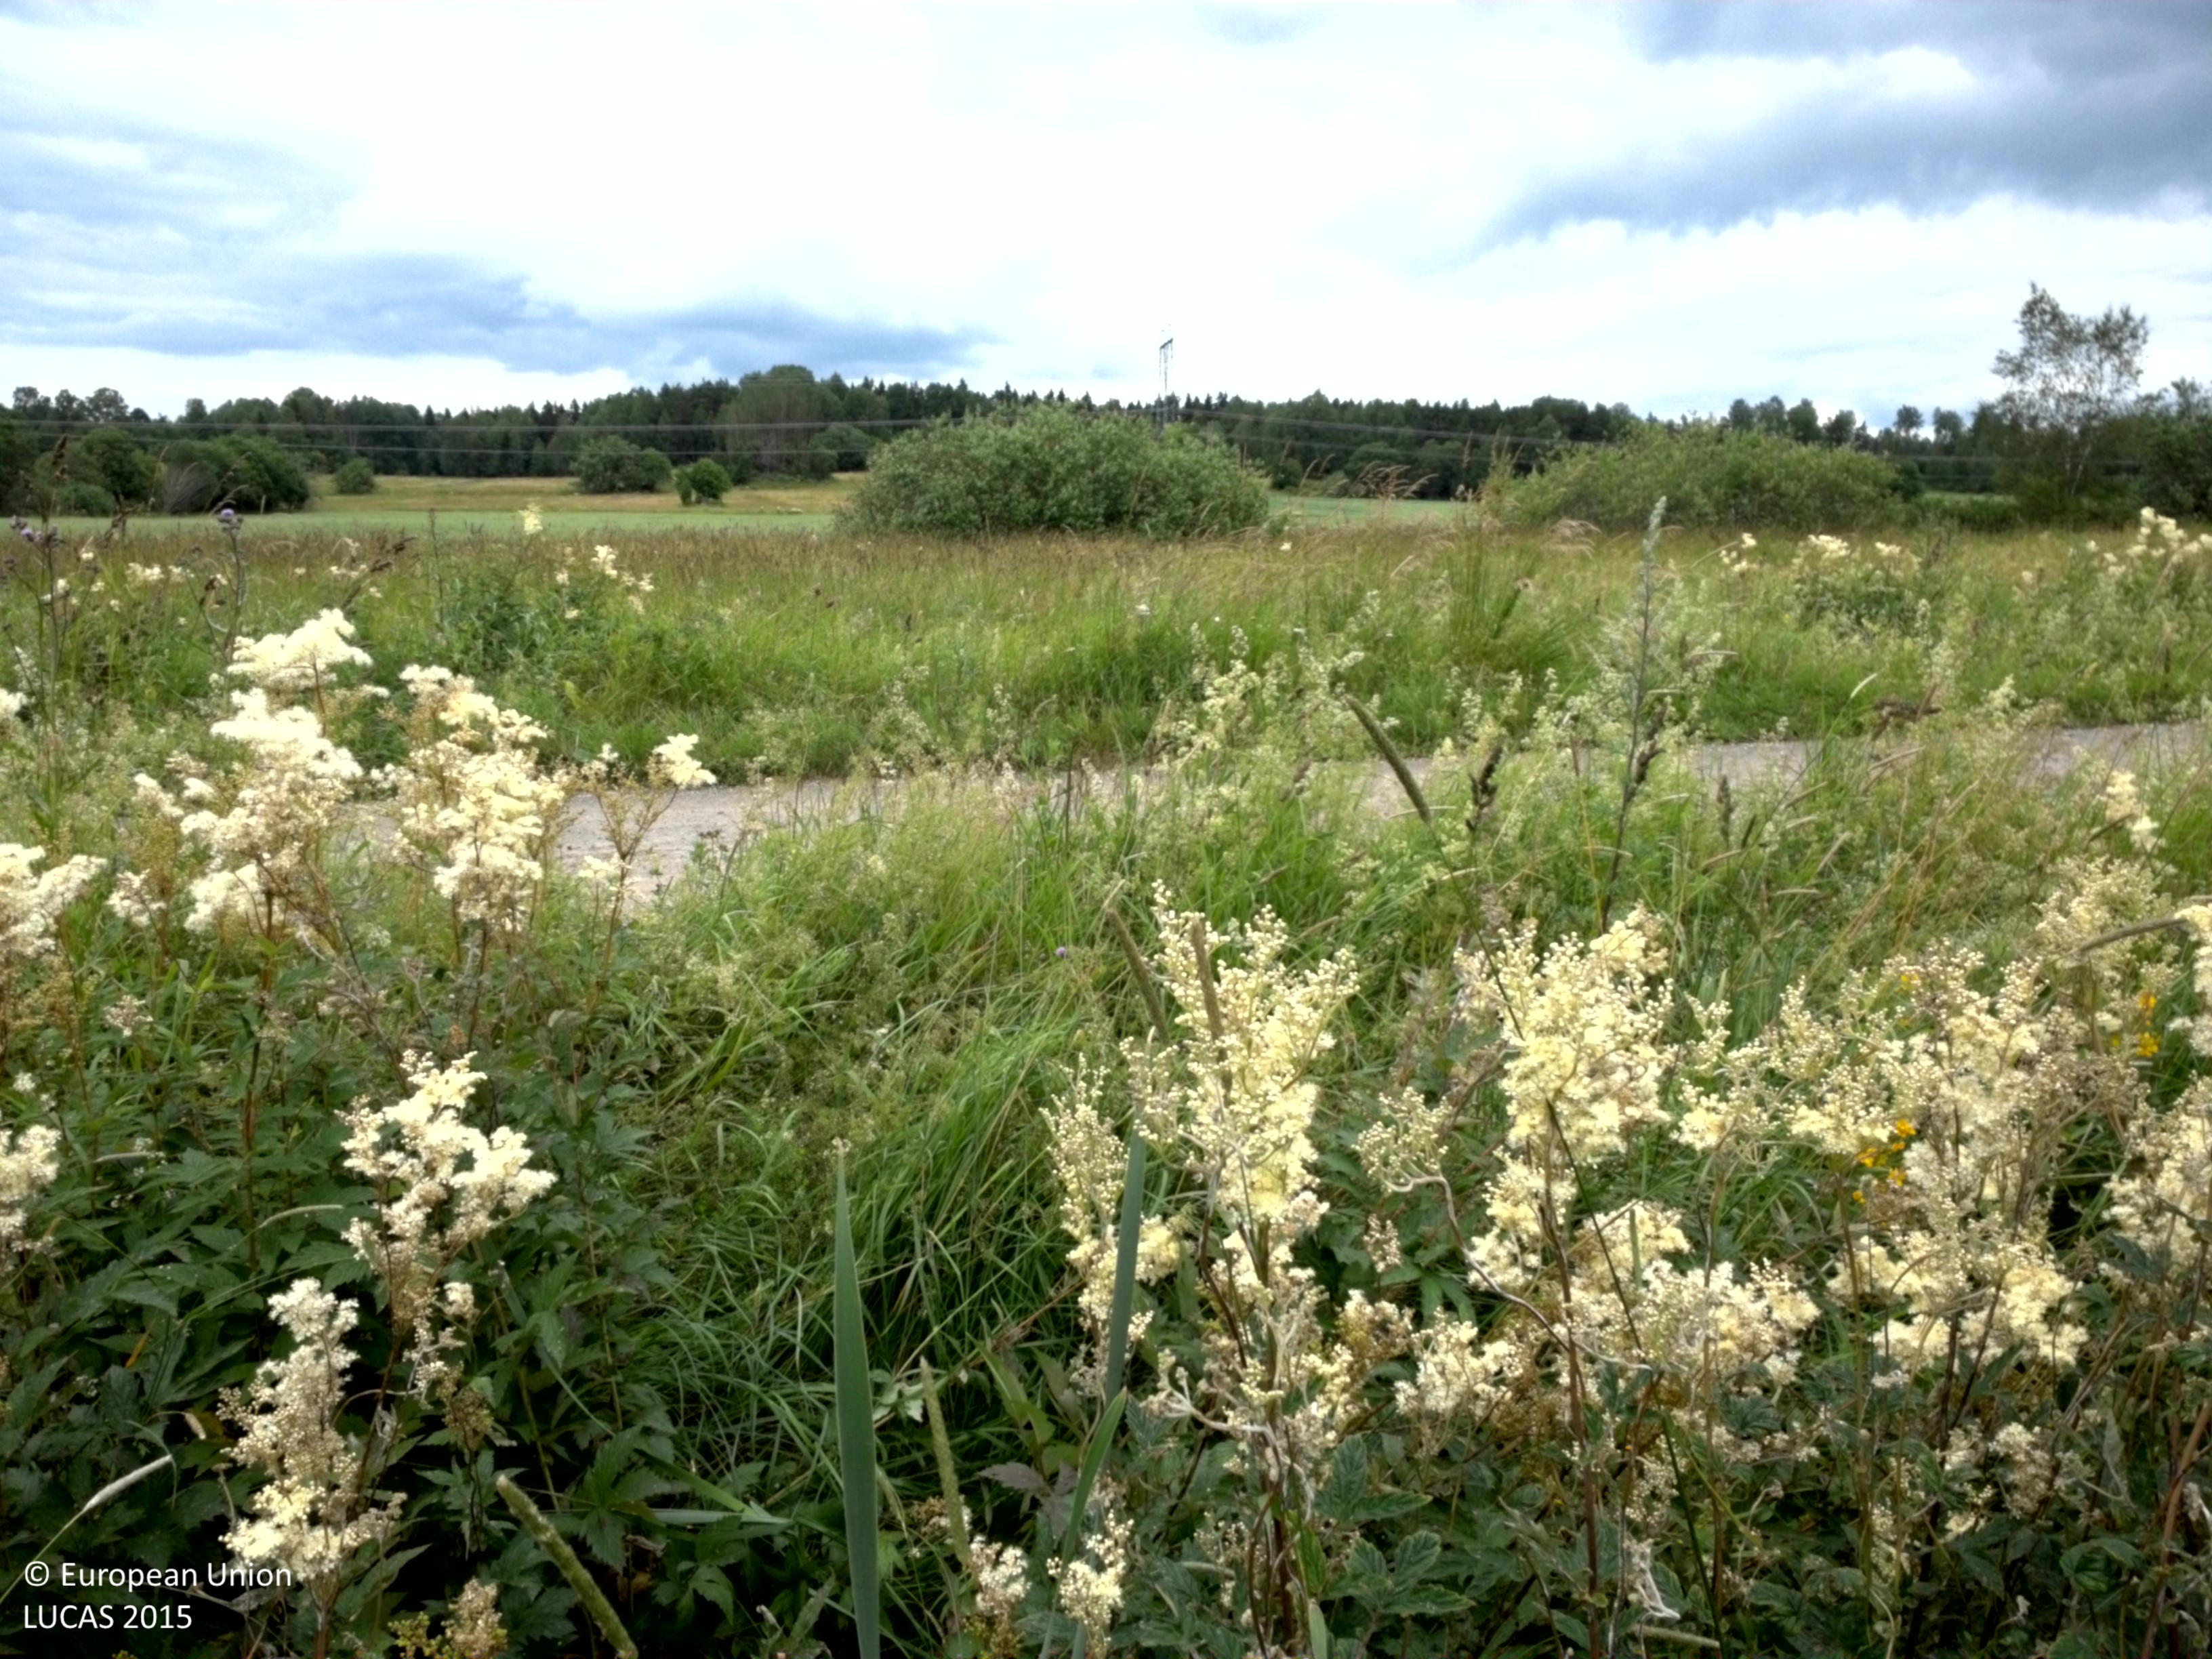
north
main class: Grassland
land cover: Spontaneously vegetated surfaces
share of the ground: 50 - 75 %
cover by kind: herbaceous plants 60 %, unconsolidated bare surface 40 %
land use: Agriculture (excluding fallow land and kitchen gardens)
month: July
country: SE
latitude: 59.7571
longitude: 18.5609
